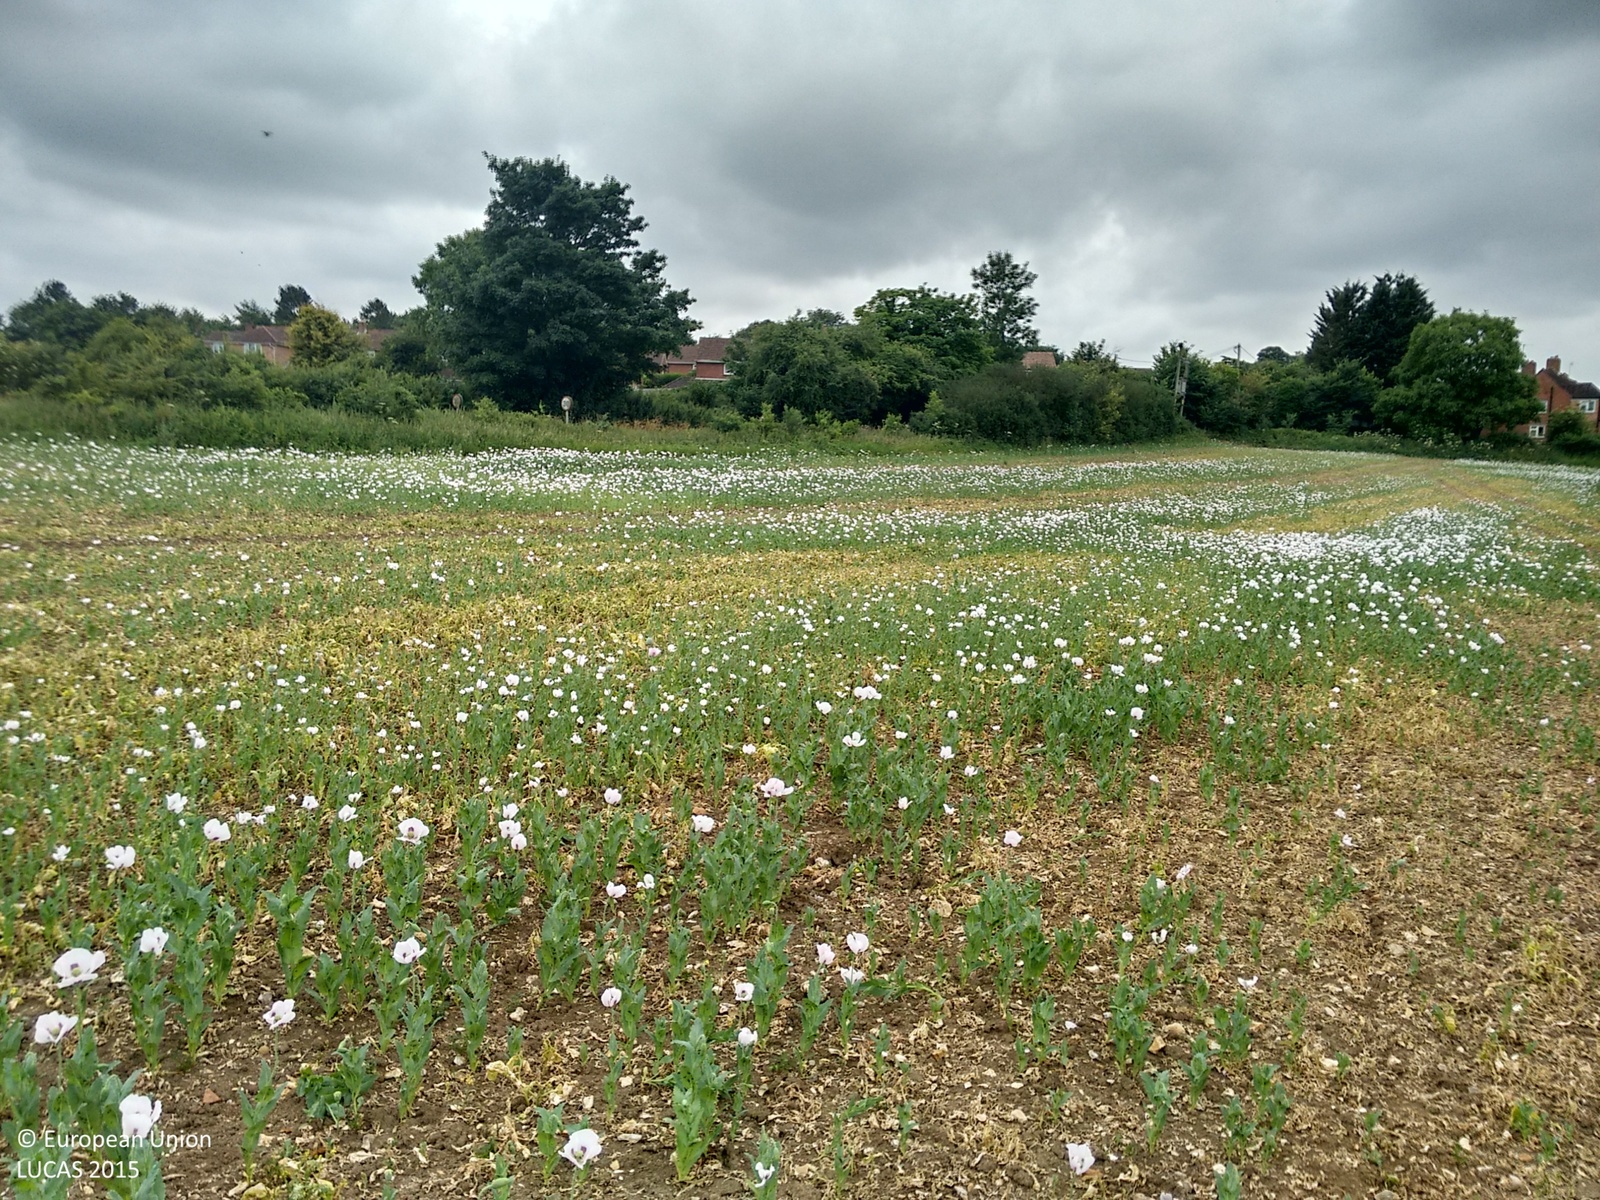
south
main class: Cropland
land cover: Other fibre and oleaginous crops
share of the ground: 25 - 50 %
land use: Agriculture (excluding fallow land and kitchen gardens)
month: July
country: GB
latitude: 51.6223
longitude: -1.0663
